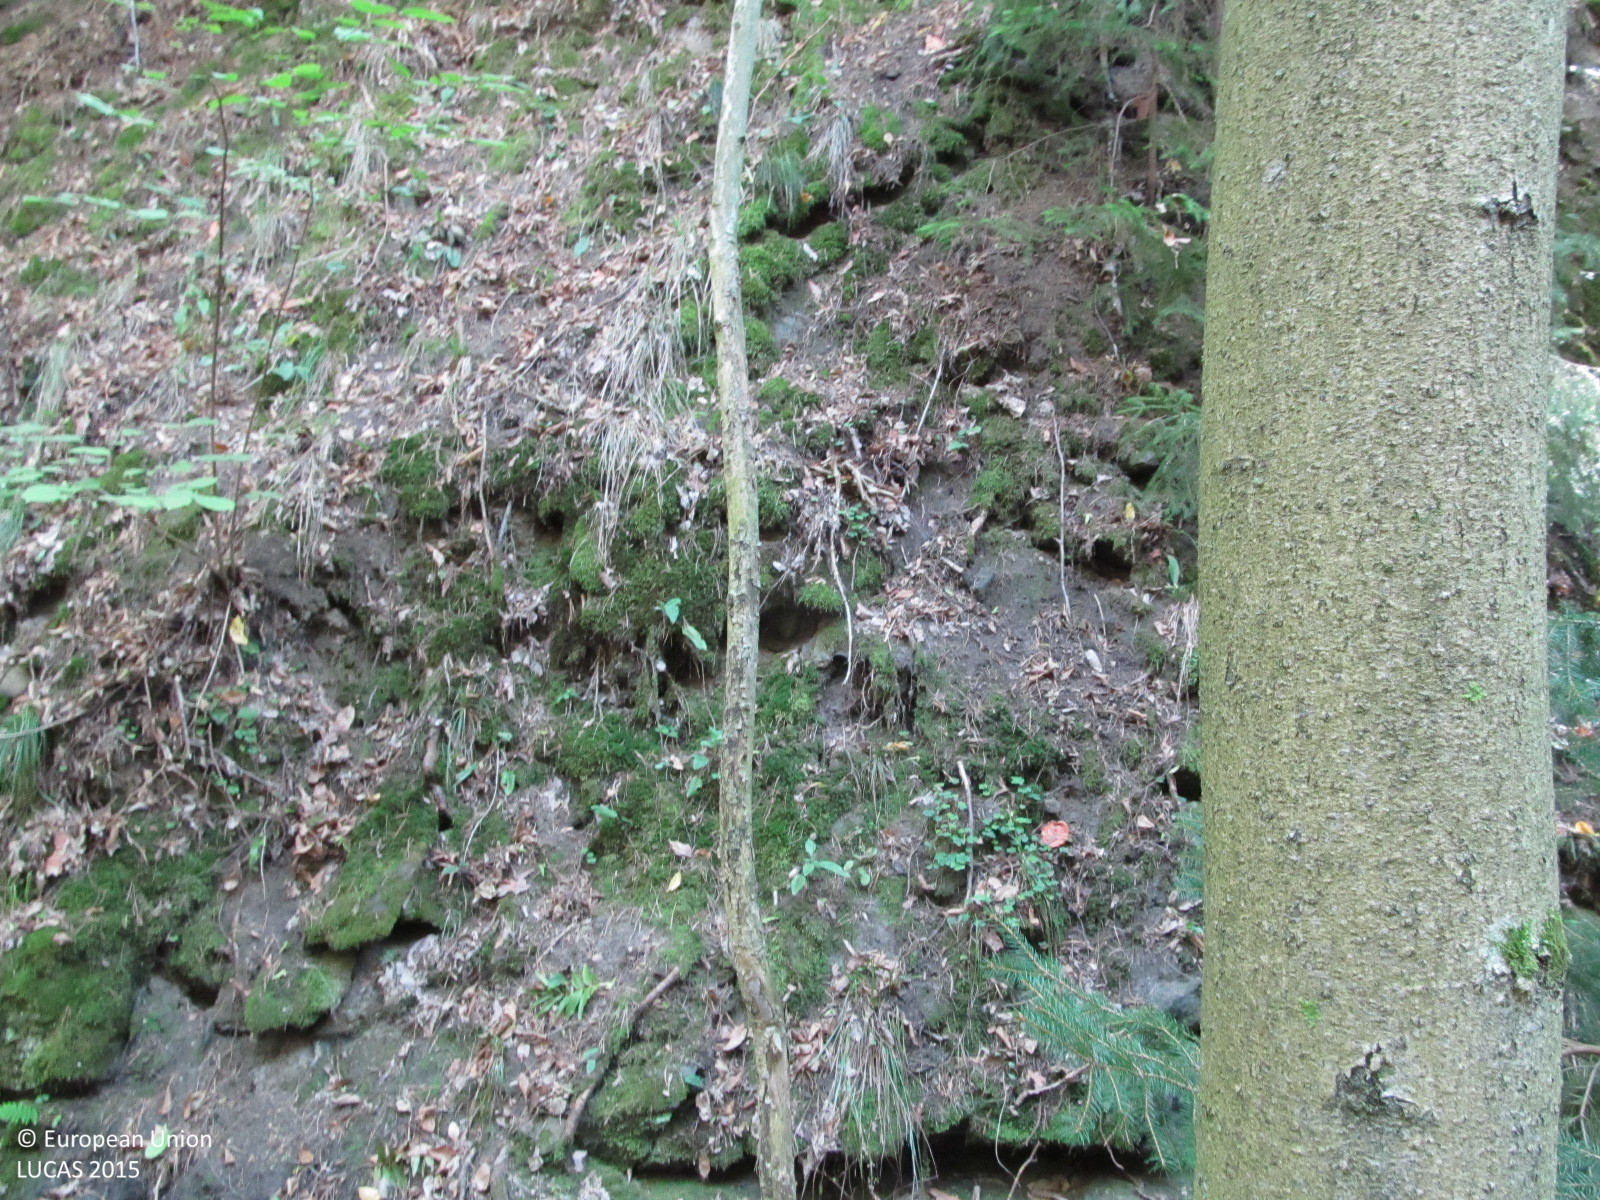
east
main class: Woodland
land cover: Broadleaved woodland
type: floodplain forest
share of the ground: > 75 %
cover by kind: broadleaved forest trees 80 %, unconsolidated bare surface 10 %, coniferous forest trees 5 %, herbaceous plants 5 %
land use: Forestry
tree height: > 5 m
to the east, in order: Broadleaved woodland; Pine dominated coniferous woodland; Tracks; Other mixed woodland; Other bare soil; Grassland without tree/shrub cover; Tracks; Grassland without tree/shrub cover; Other bare soil
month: September
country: AT
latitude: 48.4965
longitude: 15.5920
